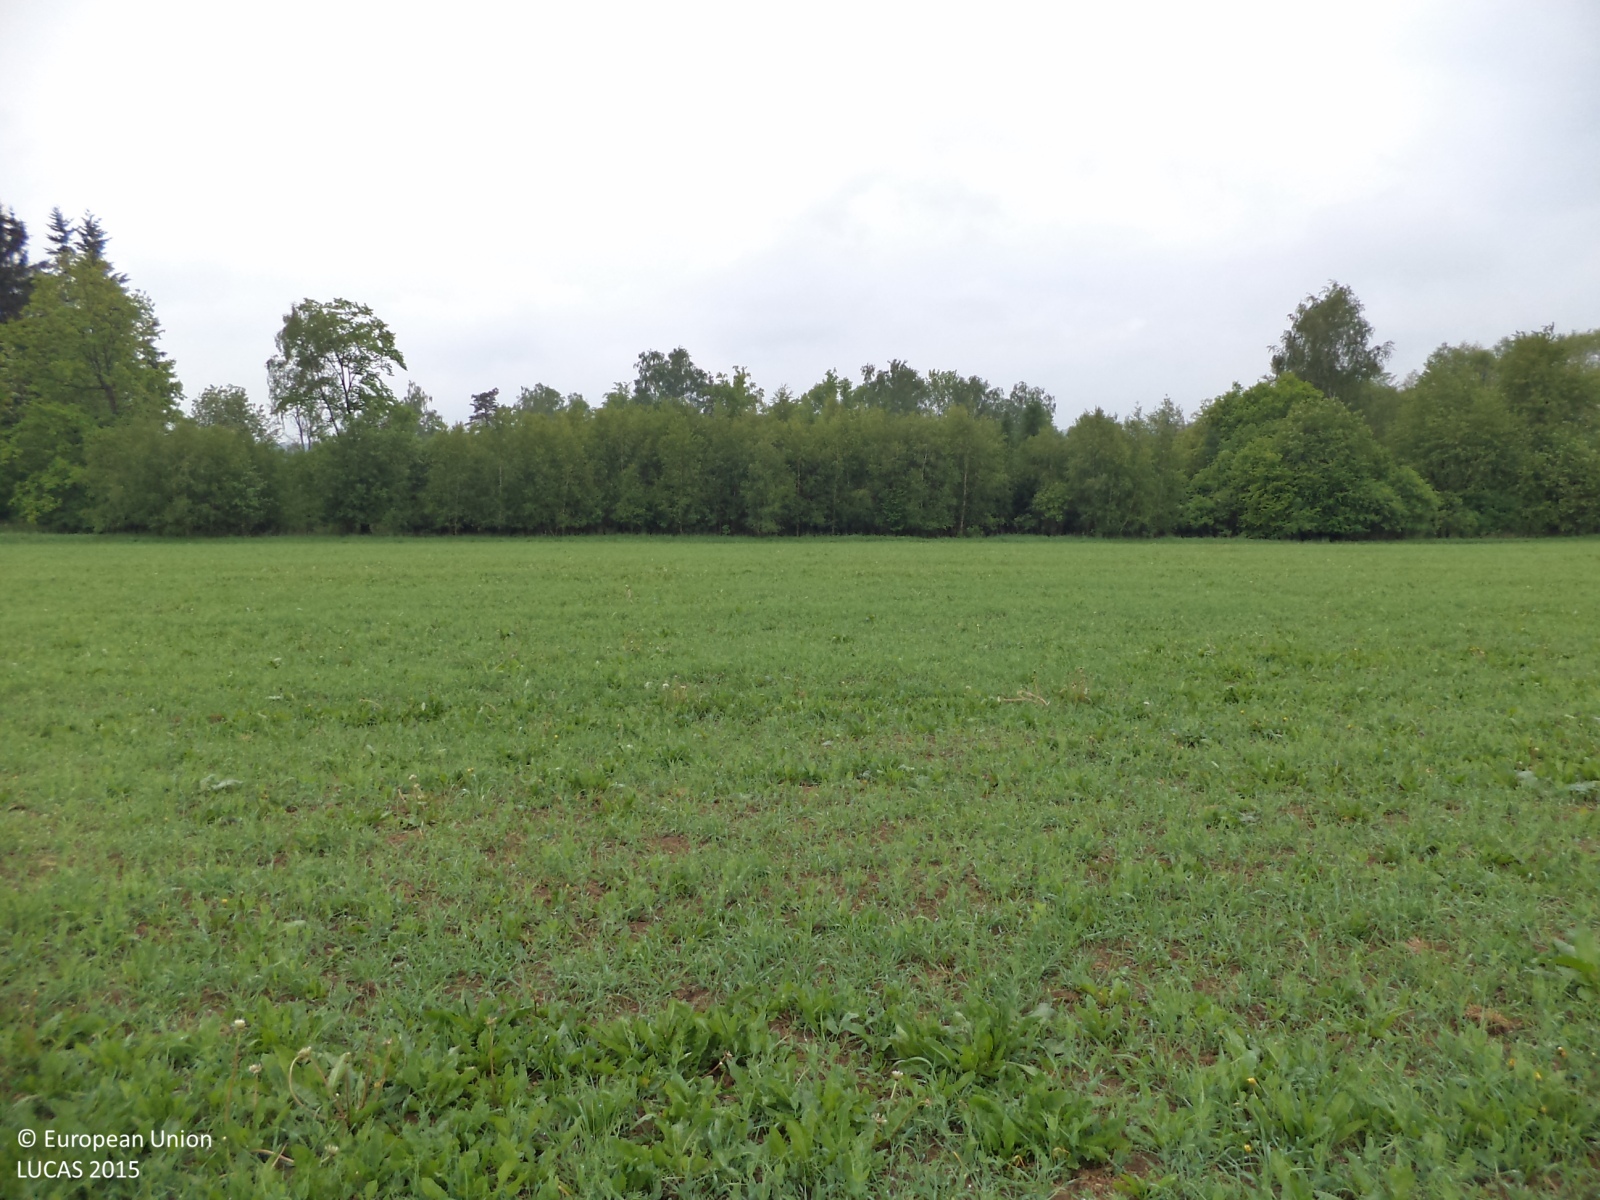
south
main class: Cropland
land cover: Other leguminous and mixtures for fodder
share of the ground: > 75 %
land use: Agriculture (excluding fallow land and kitchen gardens)
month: May
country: CZ
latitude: 49.4113
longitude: 14.9228
